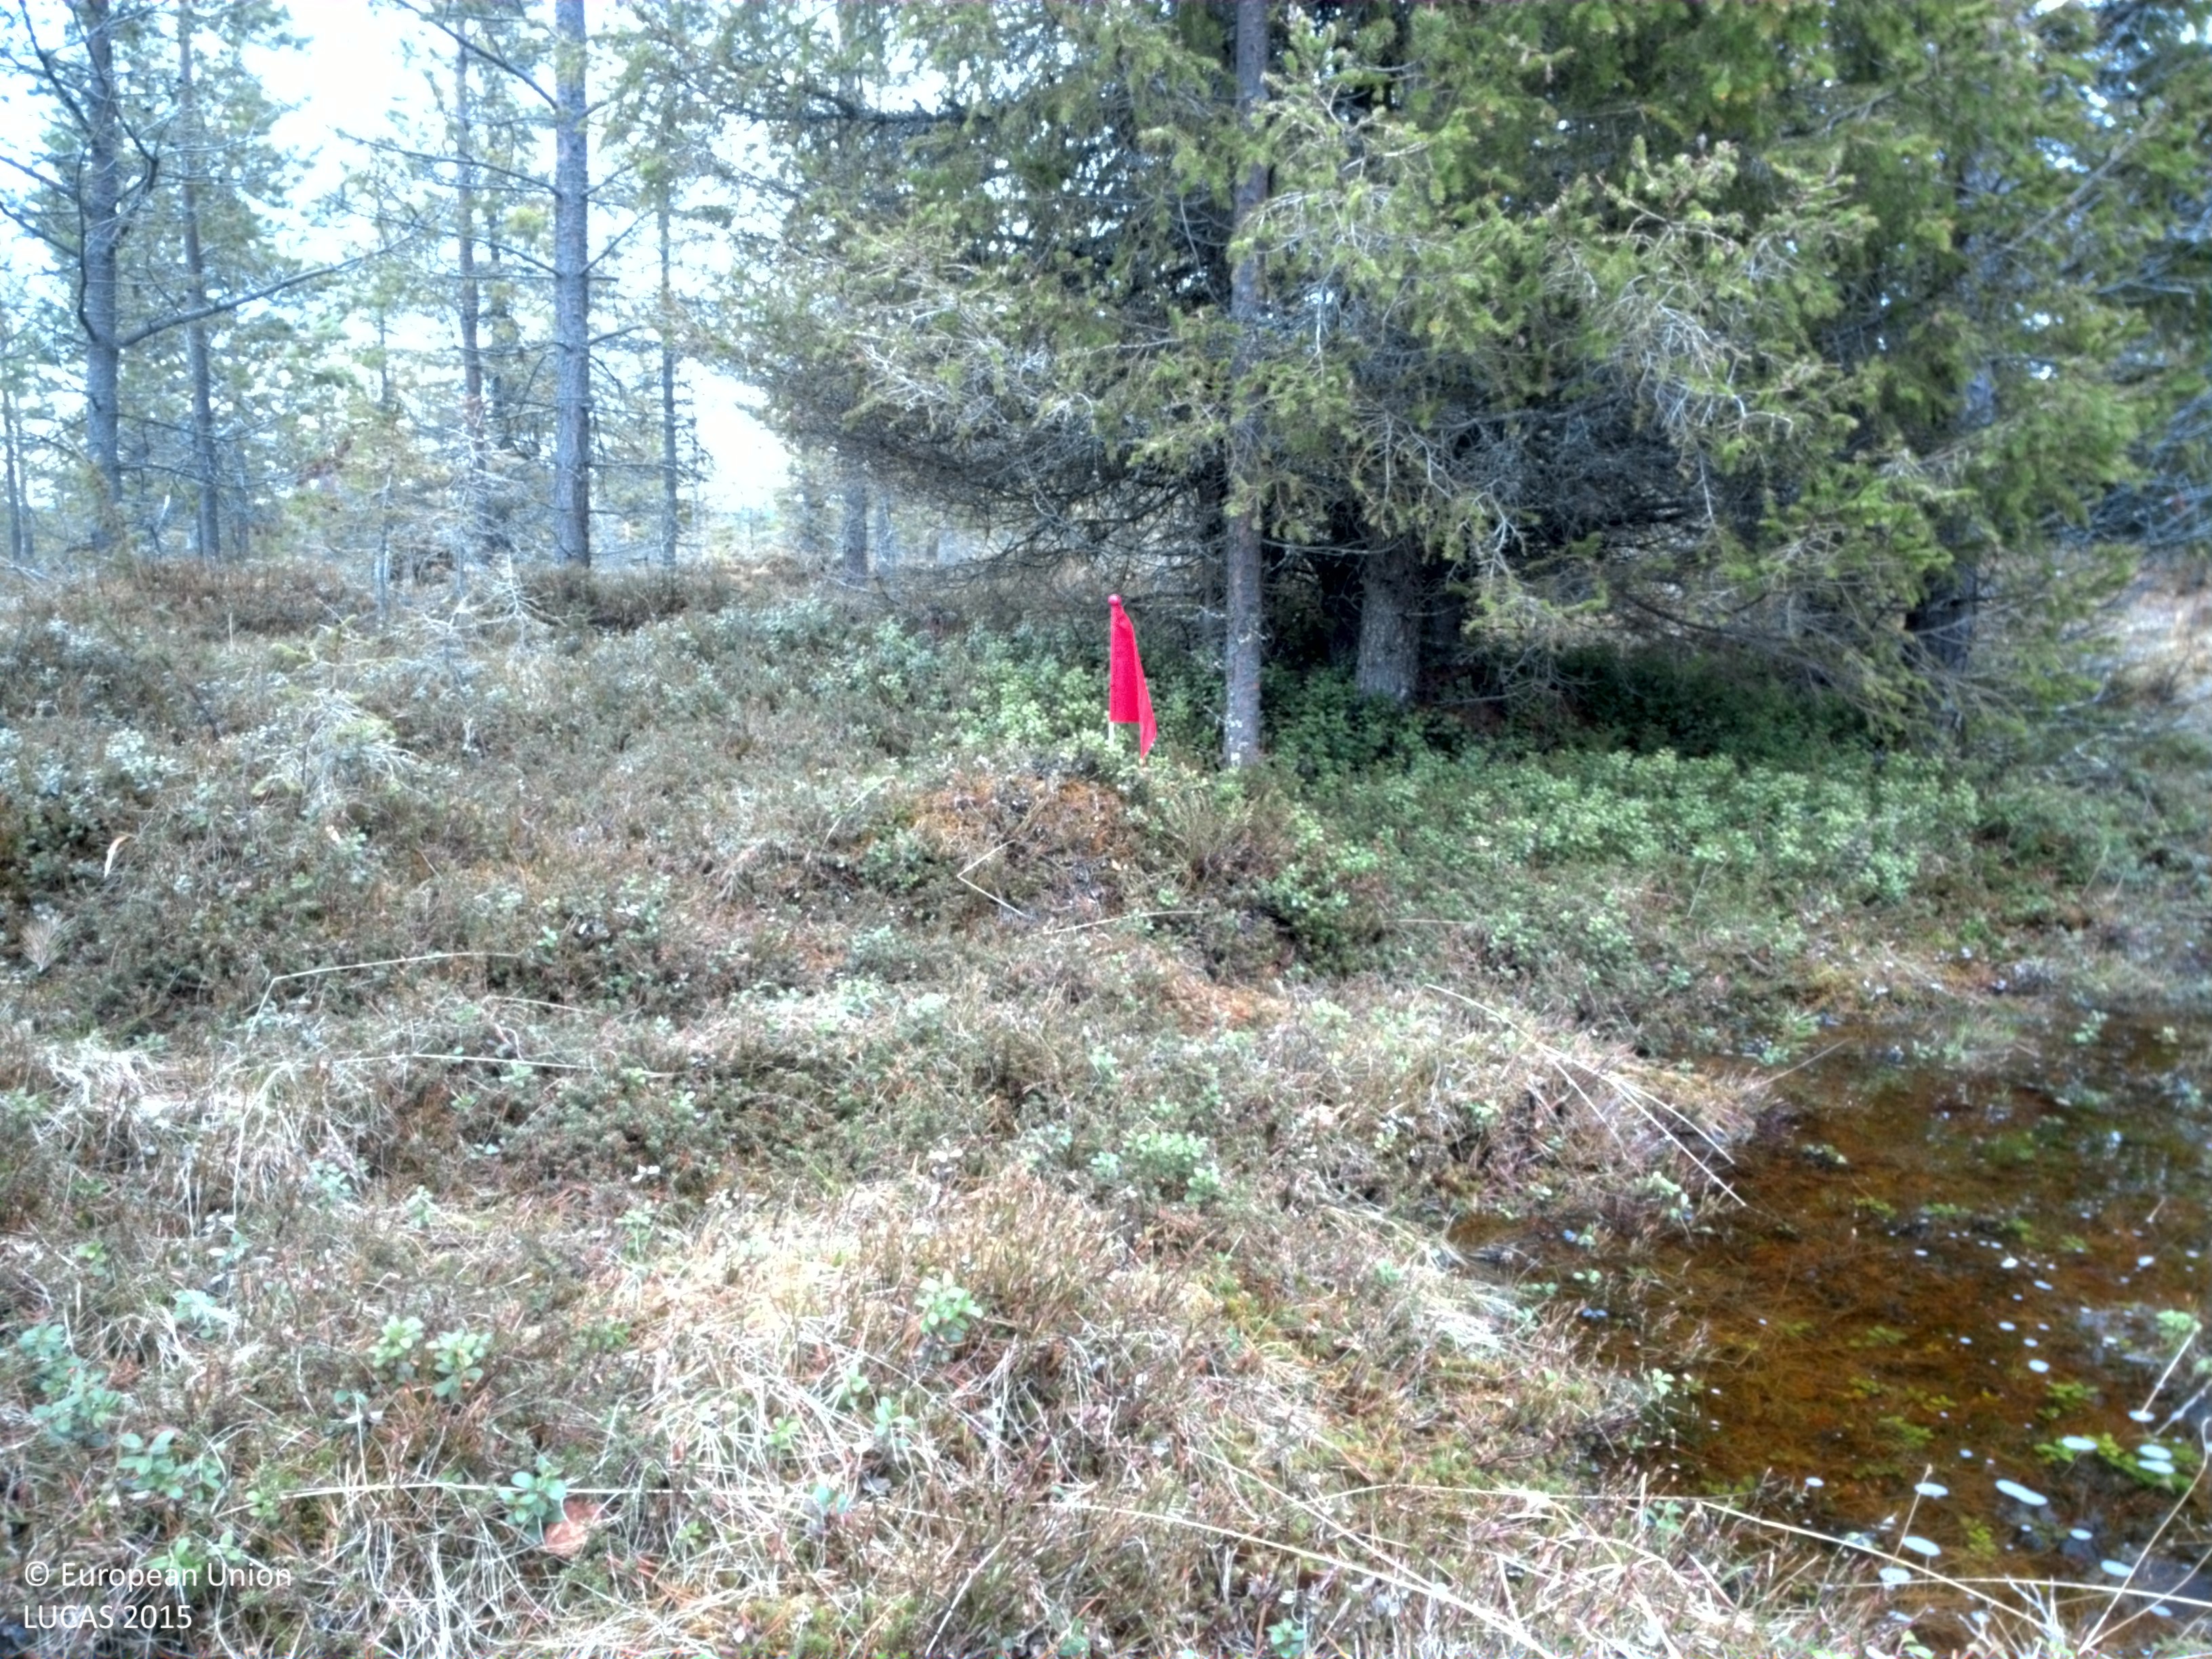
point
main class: Woodland
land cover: Other coniferous woodland
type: boreal forest
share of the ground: 50 - 75 %
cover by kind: coniferous forest trees 75 %, lichens and mosses 15 %, shrubs 10 %
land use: Forestry
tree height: > 5 m
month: June
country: SE
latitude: 66.9059
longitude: 20.9888
